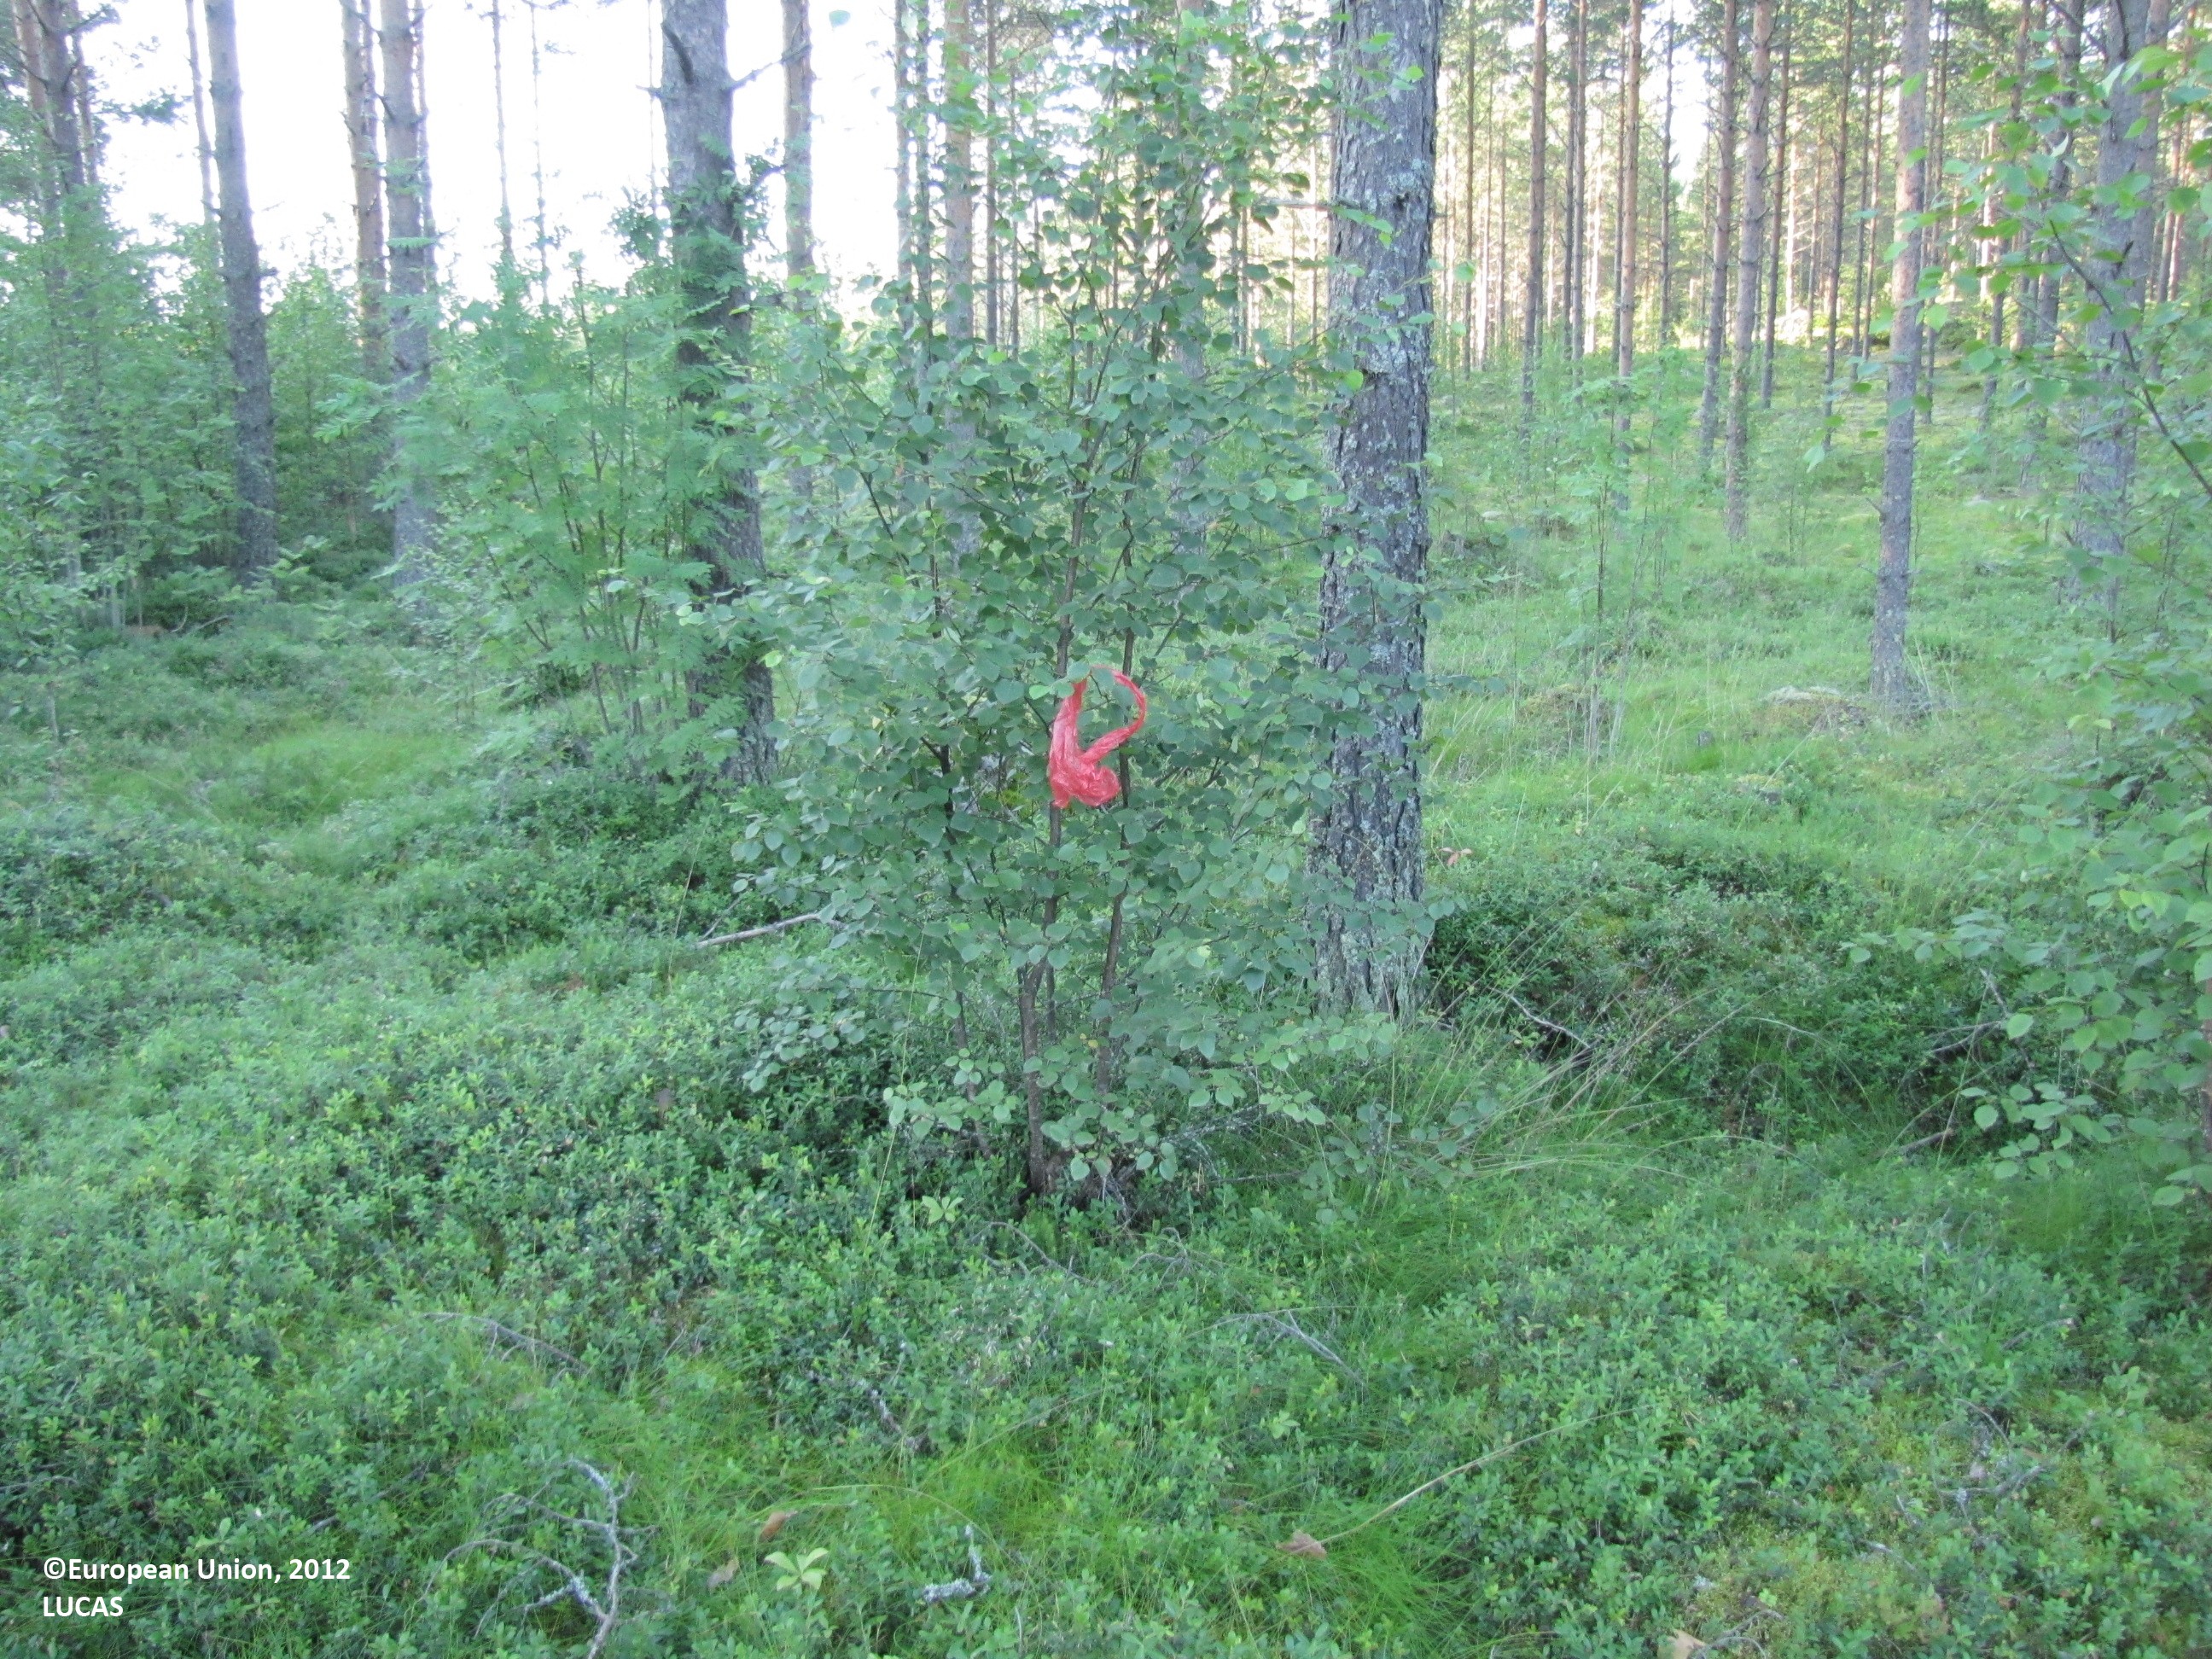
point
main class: Woodland
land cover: Pine dominated coniferous woodland
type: boreal forest
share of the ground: 50 - 75 %
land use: Forestry
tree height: > 5 m
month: July
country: FI
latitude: 62.0800
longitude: 23.0274
